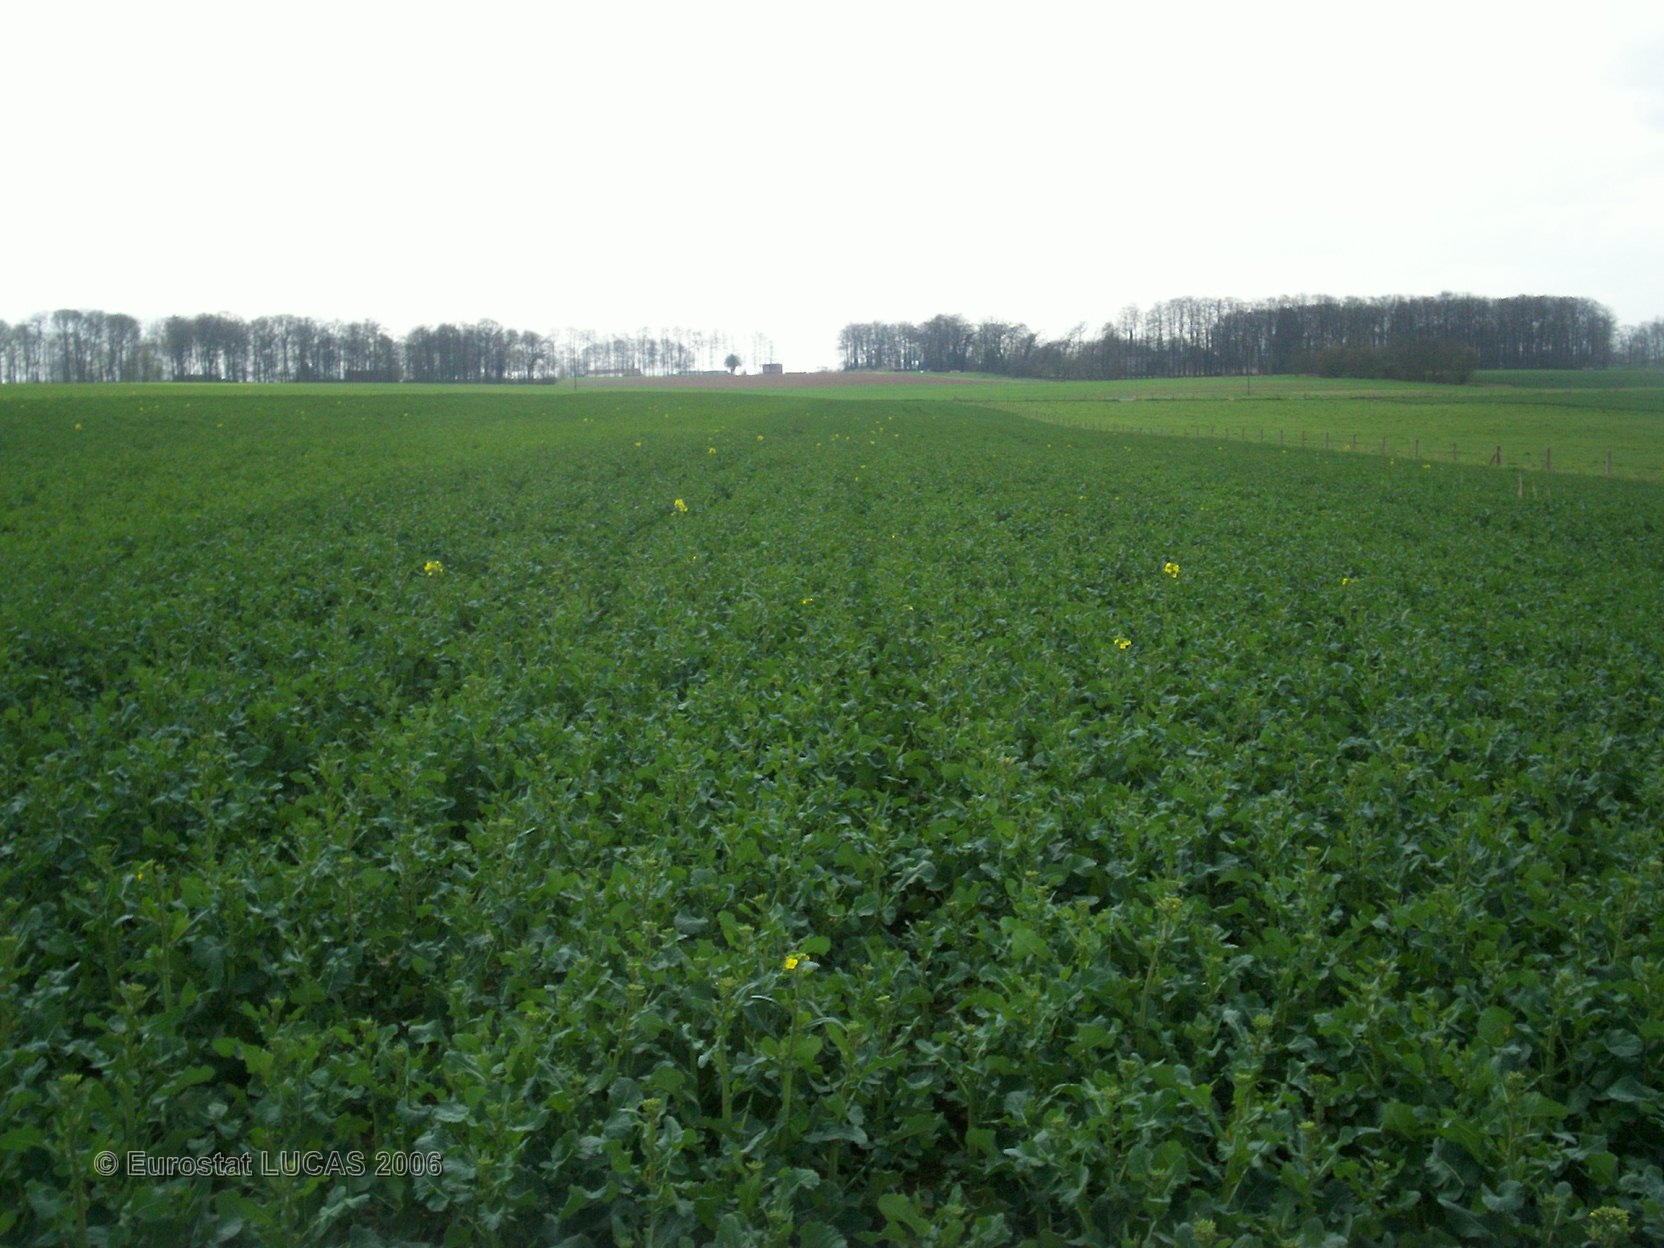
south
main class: Cropland
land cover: Rape and turnip rape
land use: Agriculture (excluding fallow land and kitchen gardens)
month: April
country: FR
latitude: 49.6593
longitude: 0.9308
